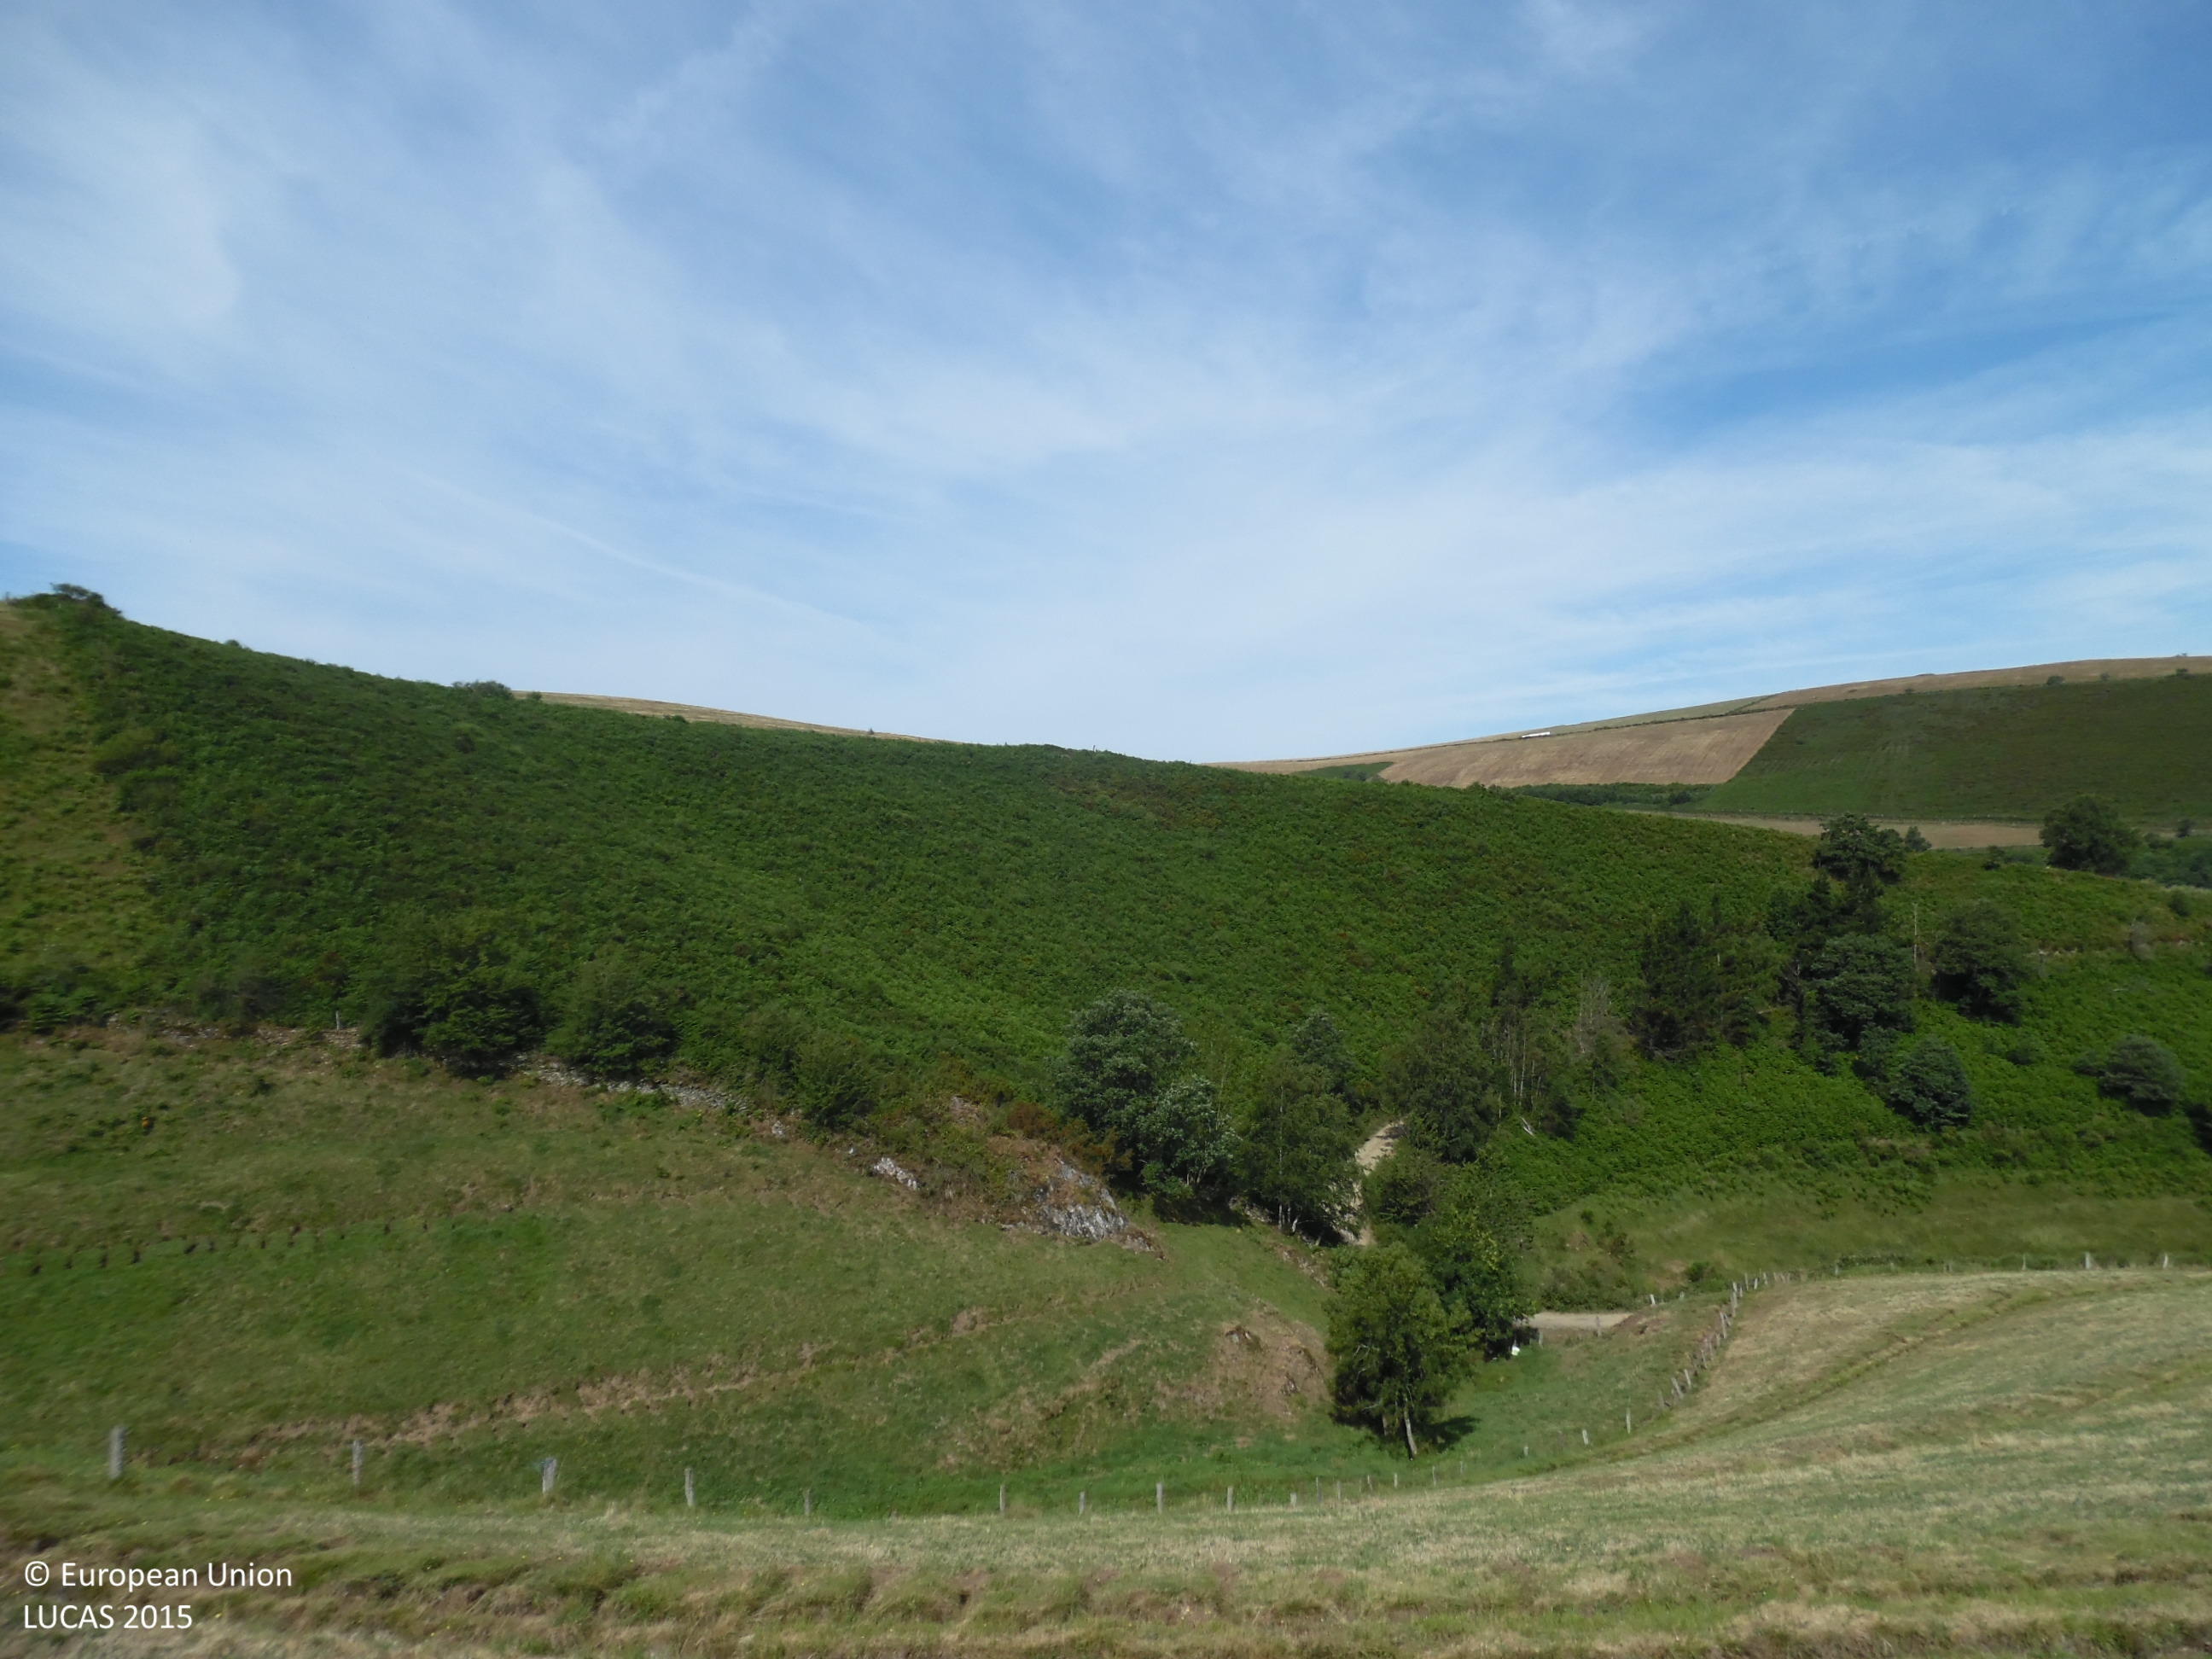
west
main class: Cropland
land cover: Temporary grasslands
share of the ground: > 75 %
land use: Agriculture (excluding fallow land and kitchen gardens)
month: July
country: ES
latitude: 43.1680
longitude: -6.5978
